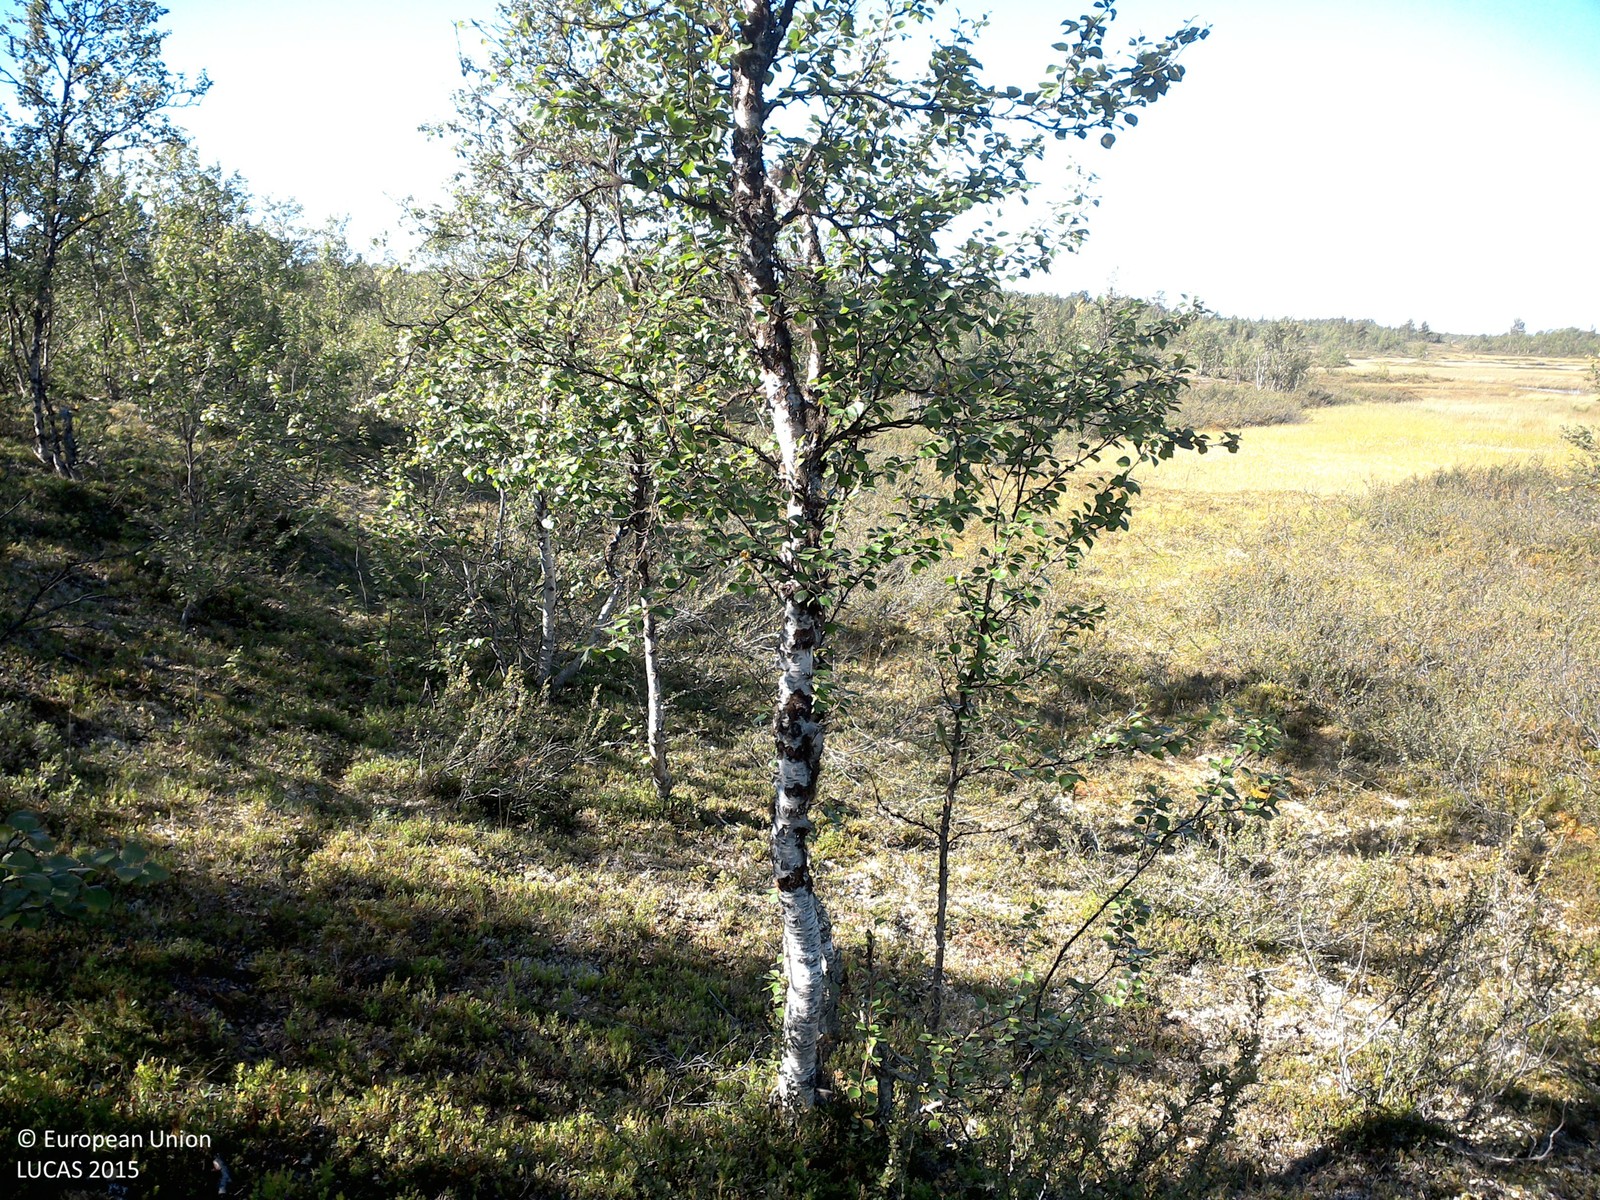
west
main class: Woodland
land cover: Broadleaved woodland
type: boreal forest
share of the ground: 10 - 25 %
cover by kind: shrubs 65 %, broadleaved forest trees 15 %, lichens and mosses 15 %, coniferous forest trees 5 %
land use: Amenities, museums, leisure
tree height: < 5 m
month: August
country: SE
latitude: 67.5457
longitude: 20.1013
